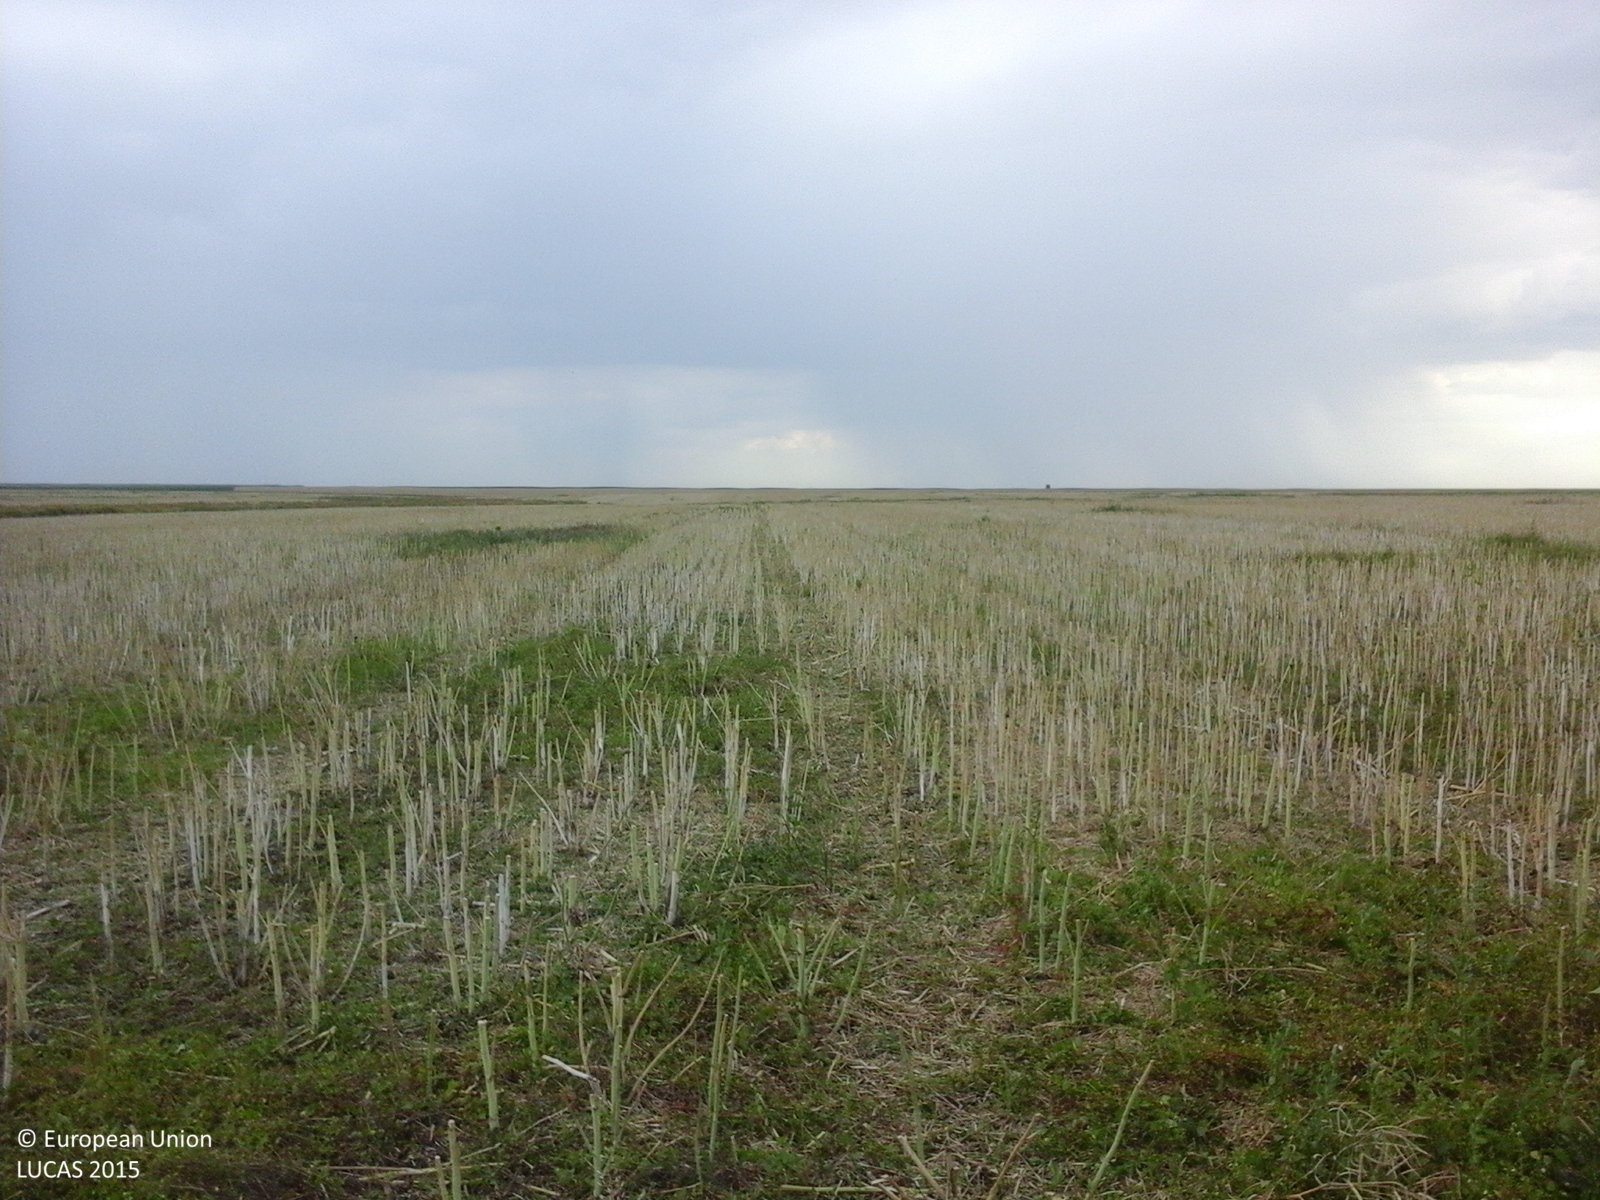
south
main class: Cropland
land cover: Rape and turnip rape
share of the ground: < 10 %
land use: Agriculture (excluding fallow land and kitchen gardens)
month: July
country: RO
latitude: 44.1201
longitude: 24.8320
